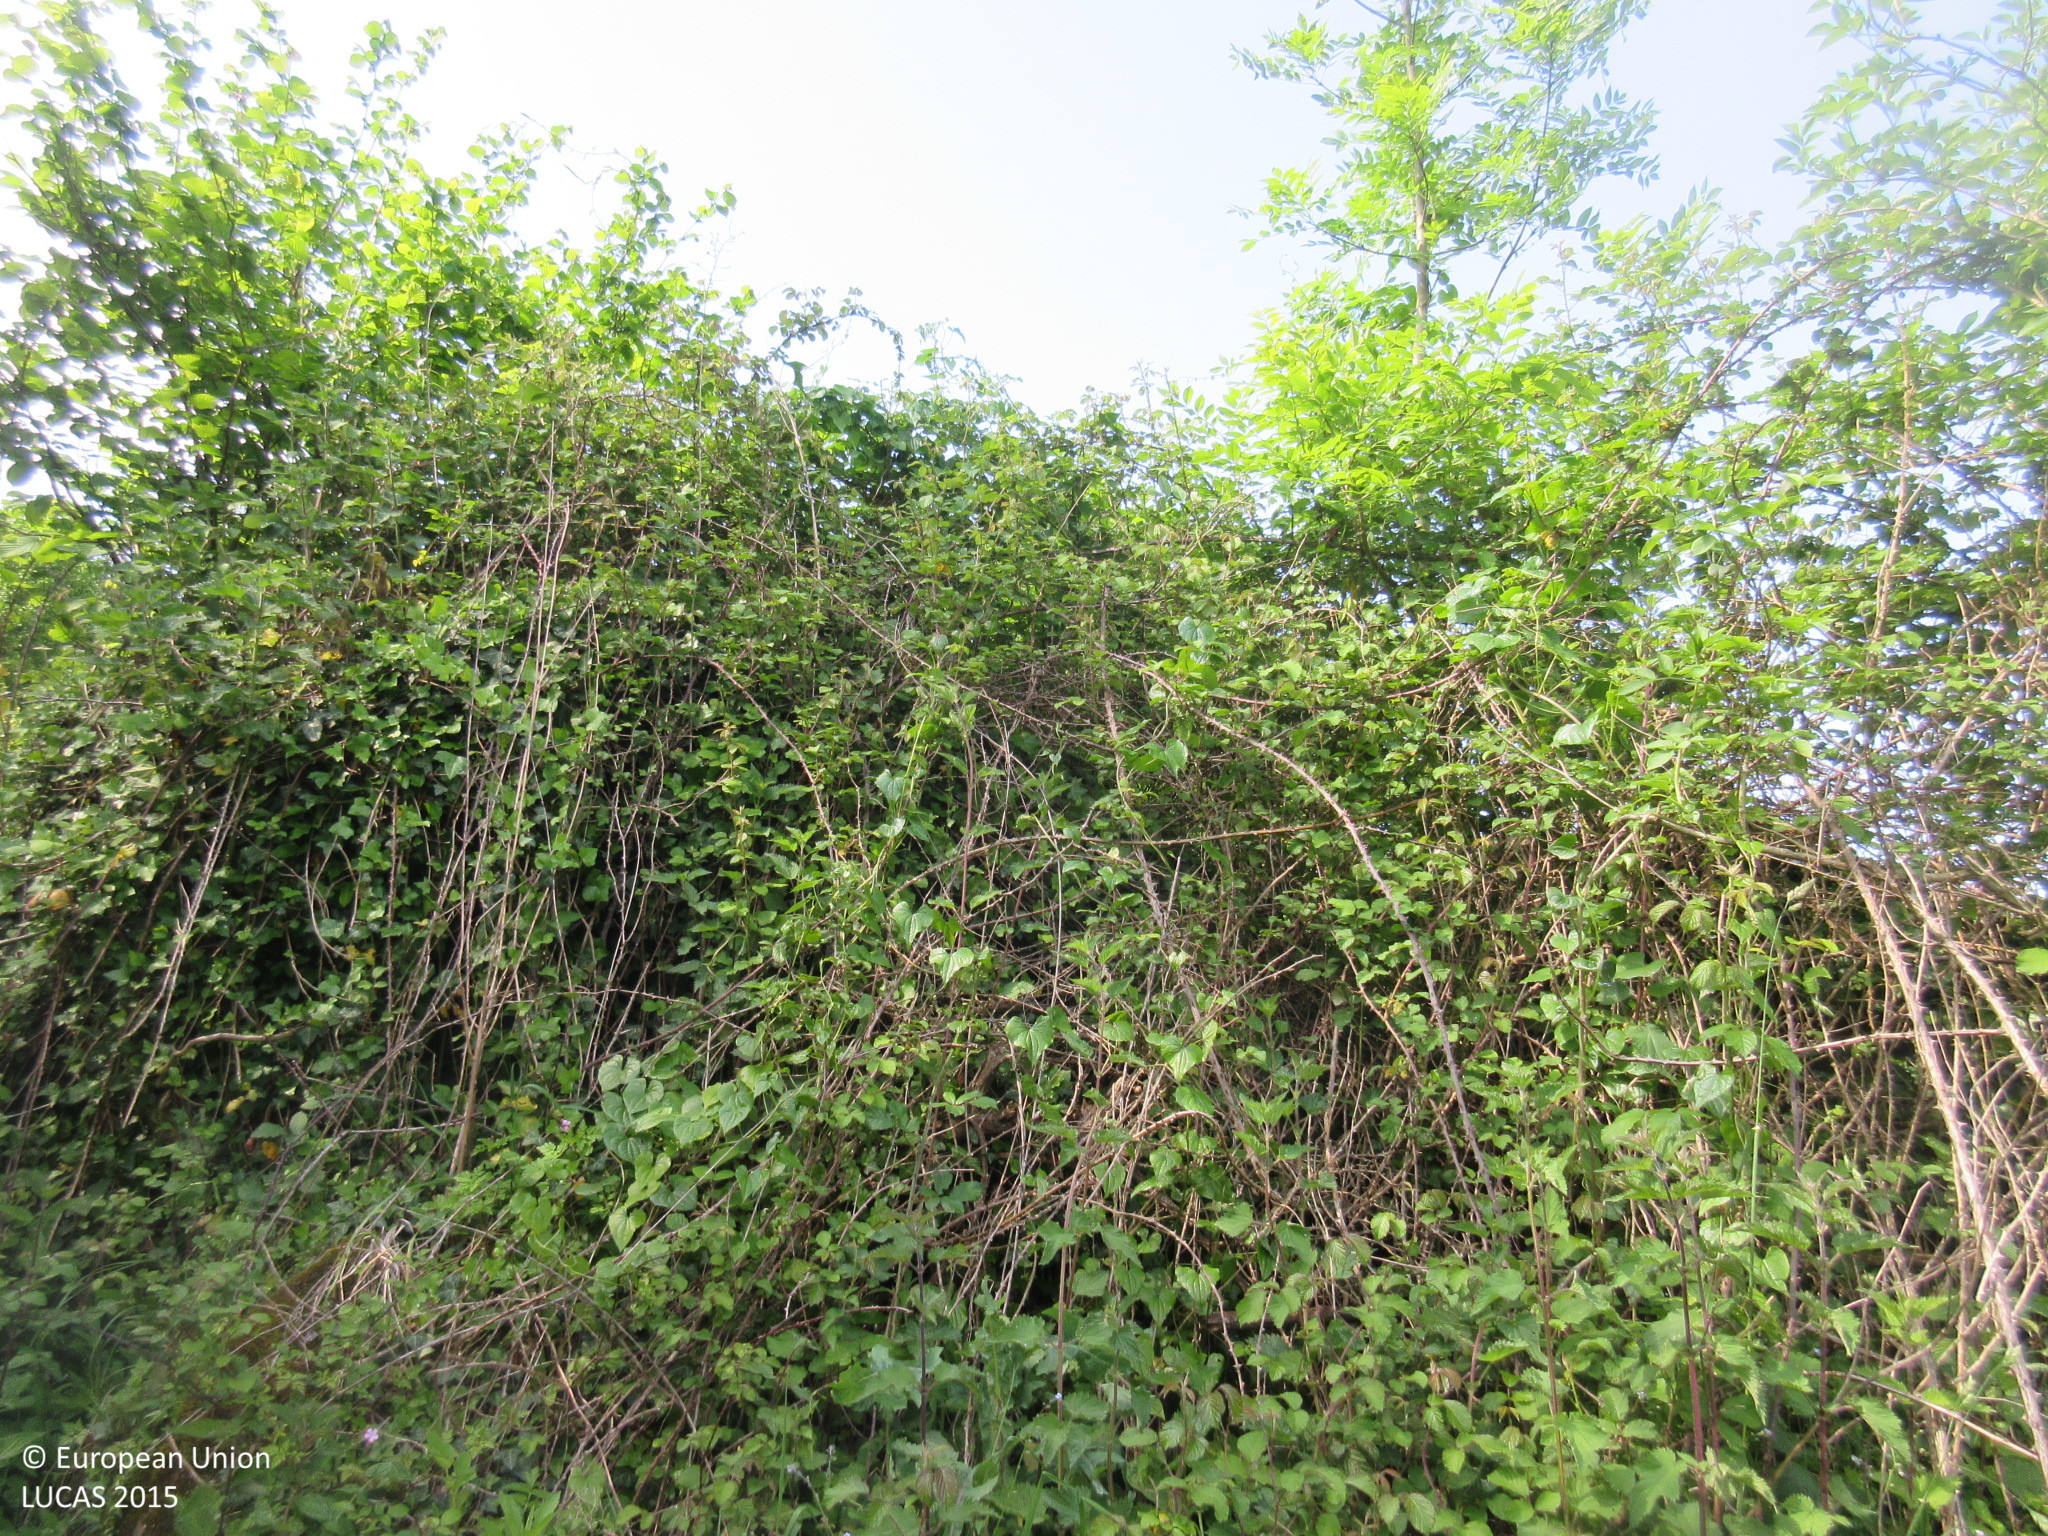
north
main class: Grassland
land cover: Grassland without tree/shrub cover
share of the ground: > 75 %
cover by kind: herbaceous plants 100 %
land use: Agriculture (excluding fallow land and kitchen gardens)
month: May
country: ES
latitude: 43.2593
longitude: -5.9175
